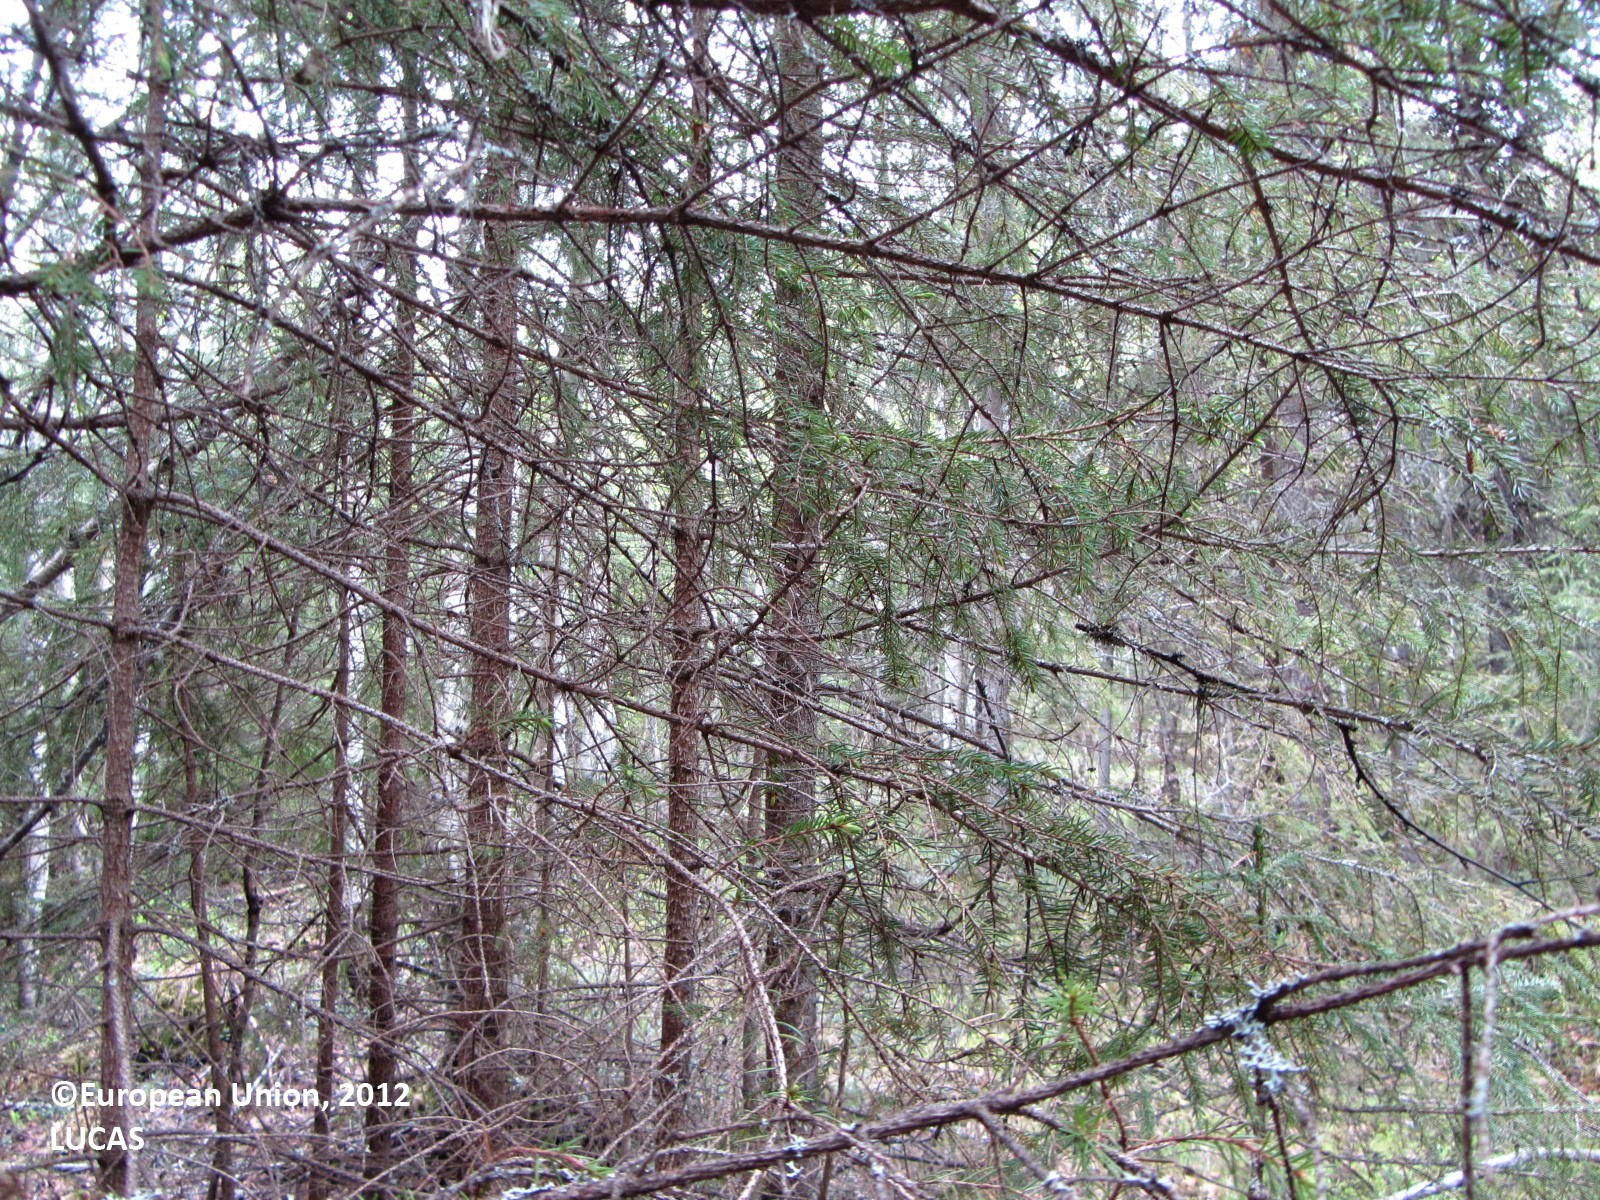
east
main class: Woodland
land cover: Spruce dominated mixed woodland
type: boreal forest
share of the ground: > 75 %
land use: Forestry
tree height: > 5 m
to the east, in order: Spruce dominated mixed woodland; Ditches and canals; Spruce dominated mixed woodland; Rock outcrops; Spruce dominated mixed woodland; Rock outcrops; Pine dominated mixed woodland; Broadleaved woodland; Peatbogs
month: June
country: FI
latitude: 63.7951
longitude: 24.7570
